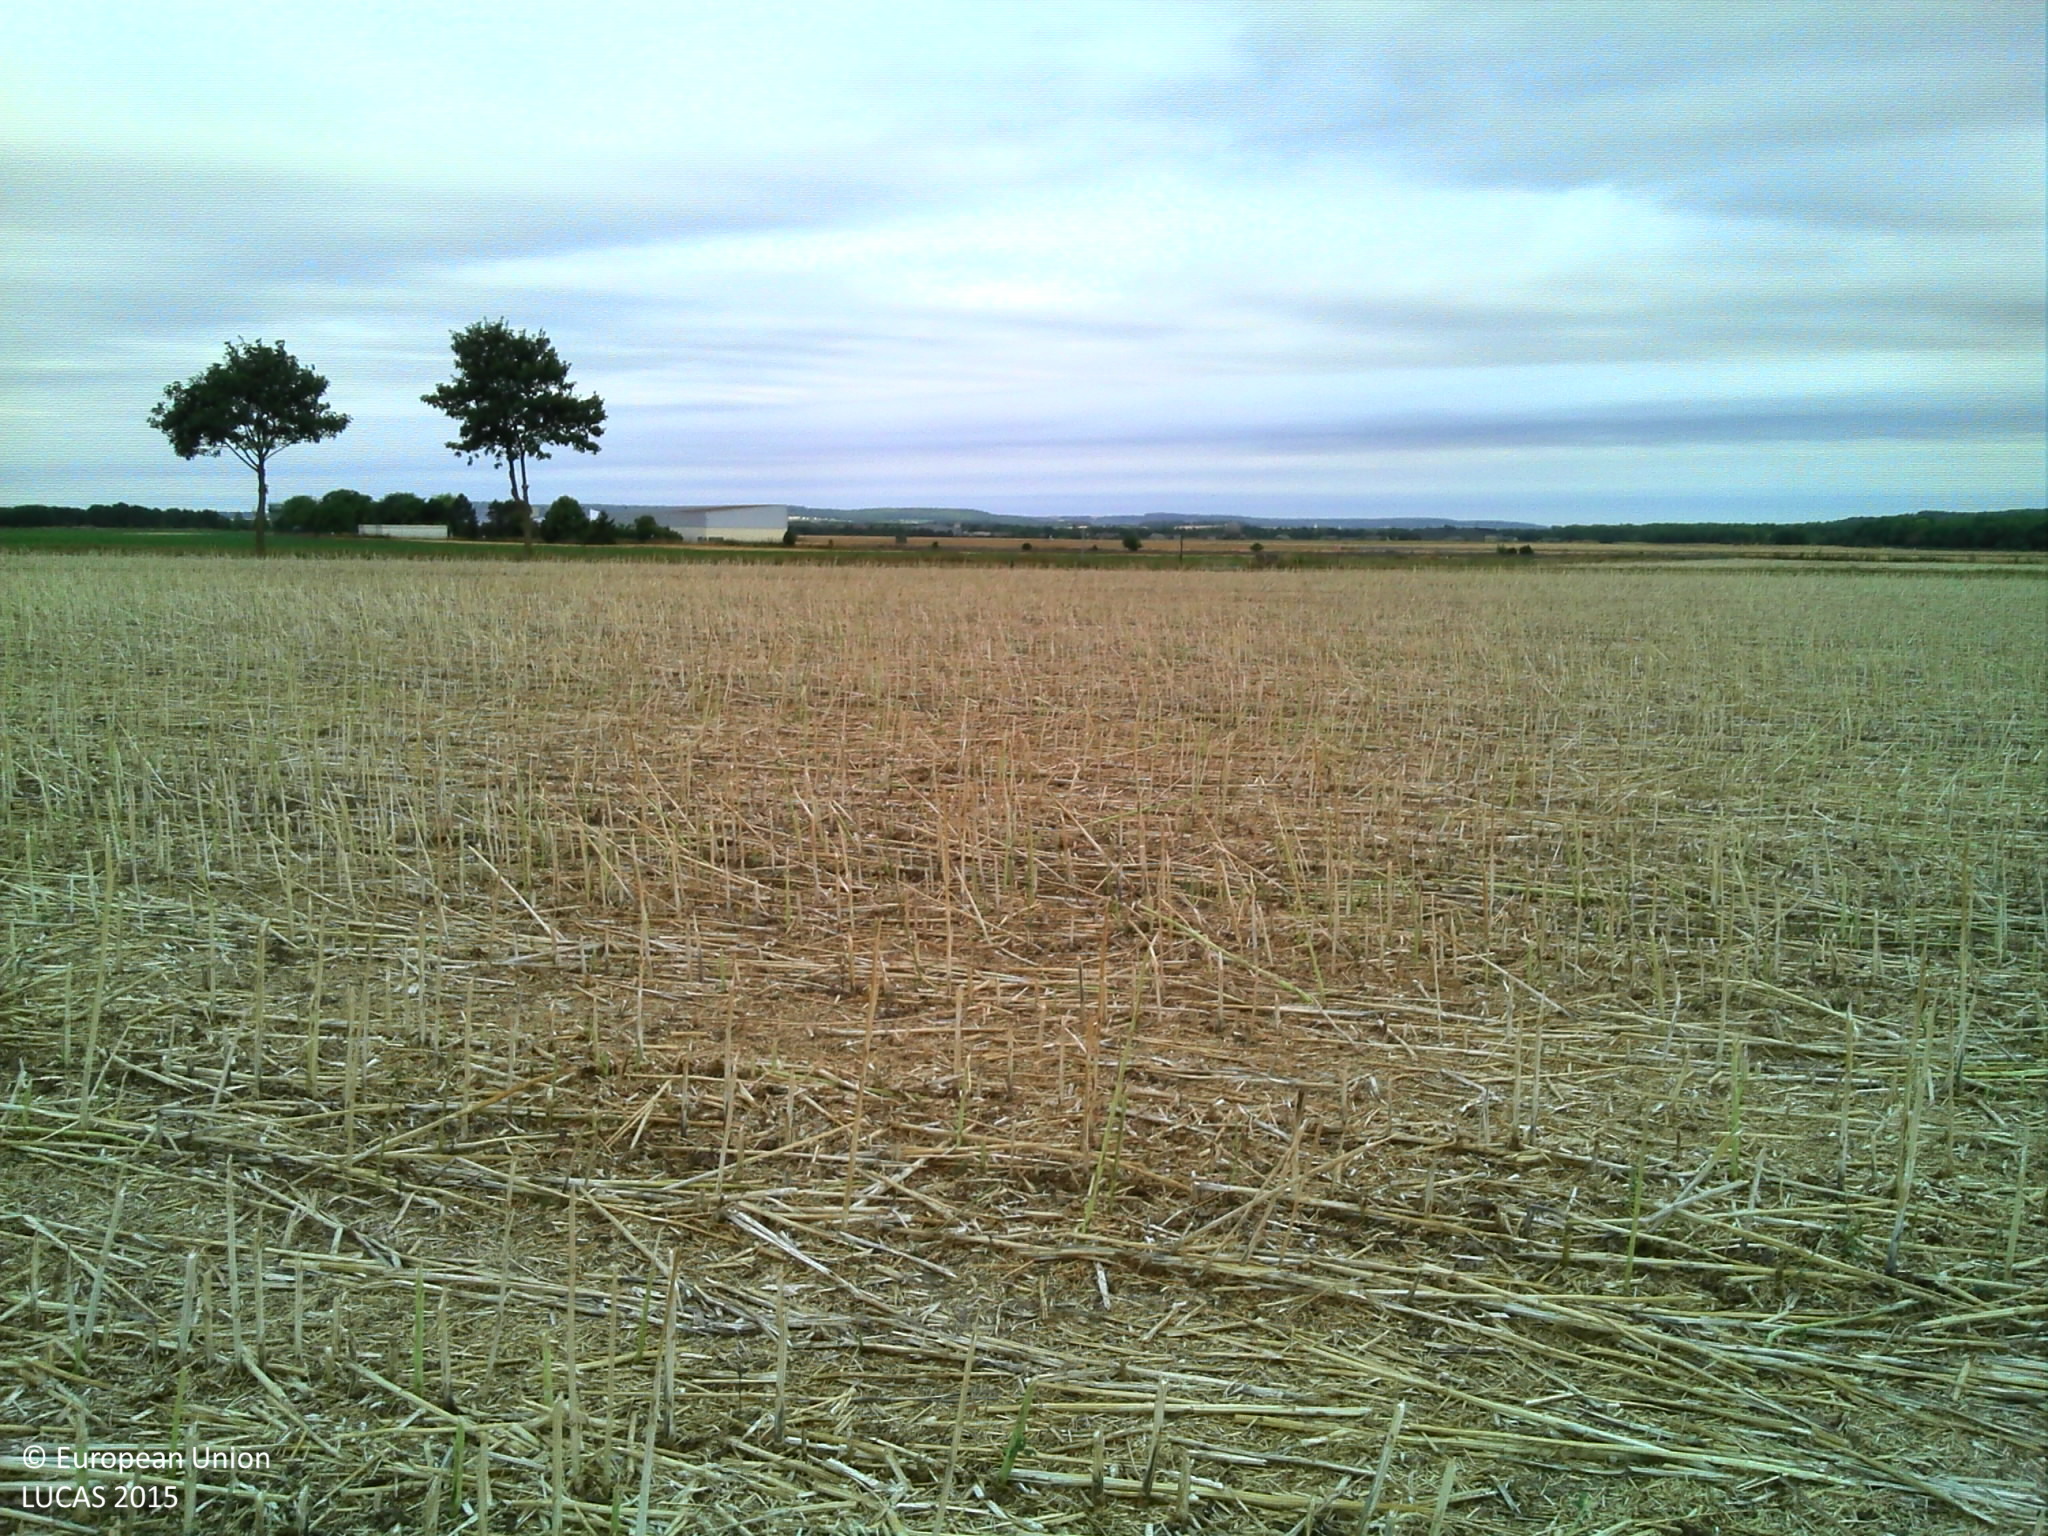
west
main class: Cropland
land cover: Rape and turnip rape
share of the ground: > 75 %
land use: Agriculture (excluding fallow land and kitchen gardens)
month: July
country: FR
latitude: 49.3084
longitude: 4.0670
